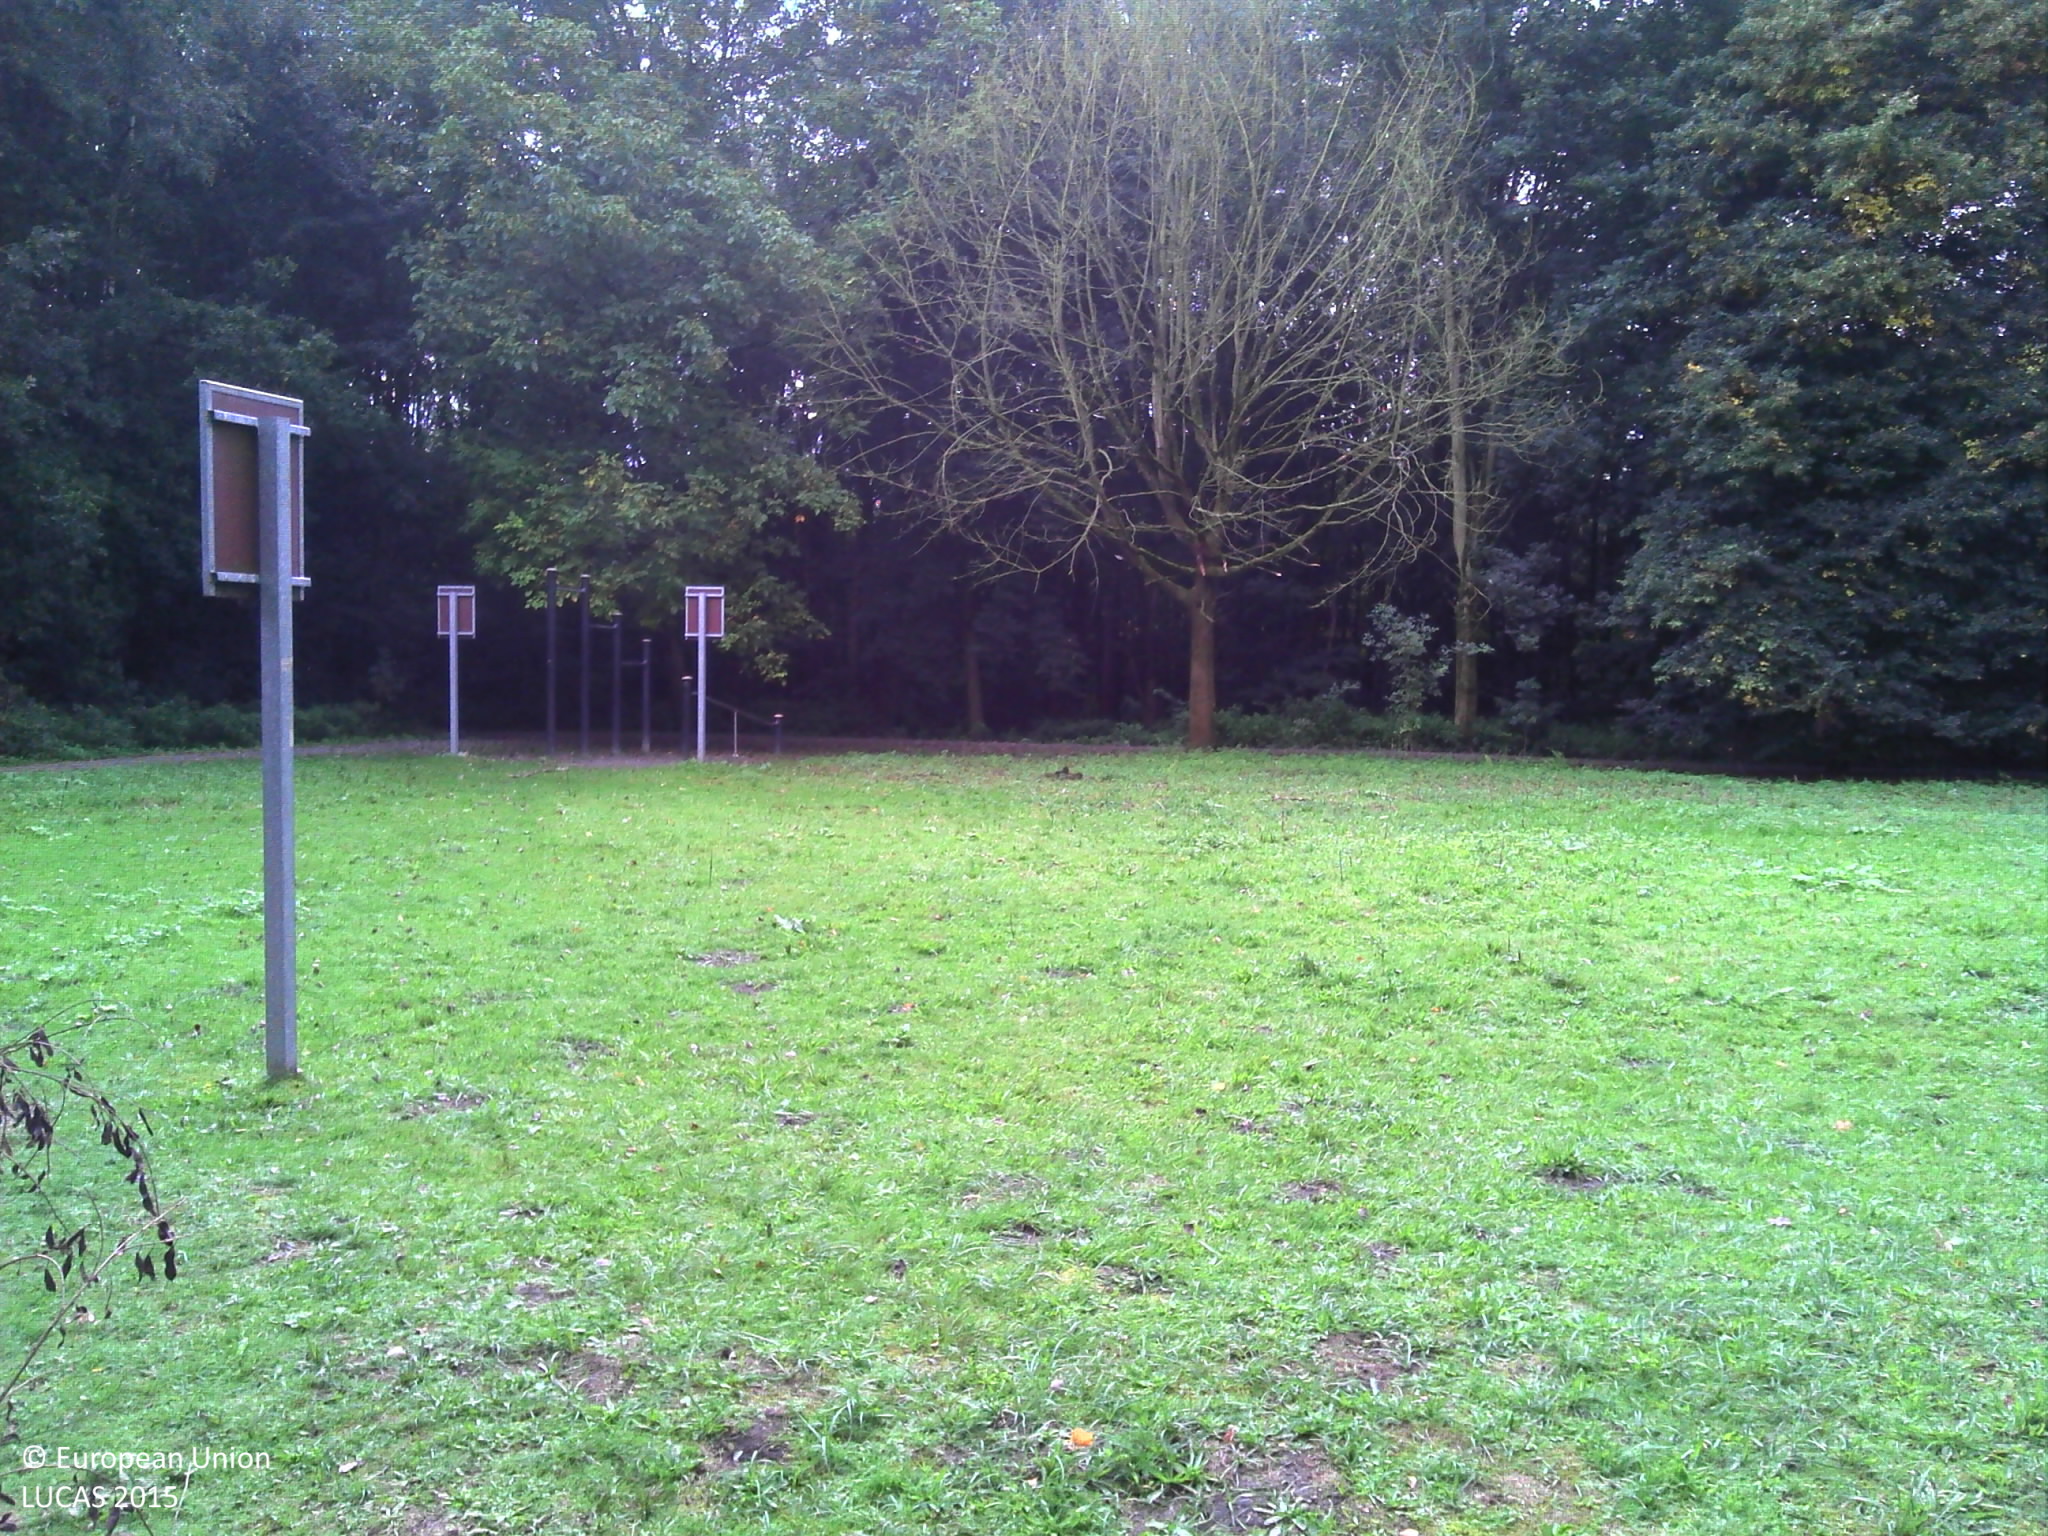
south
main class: Woodland
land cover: Broadleaved woodland
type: mesophytic deciduous forest
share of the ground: > 75 %
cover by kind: broadleaved forest trees 90 %, shrubs 5 %, herbaceous plants 5 %
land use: Amenities, museums, leisure
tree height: > 5 m
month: September
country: BE
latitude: 51.1657
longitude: 4.4325
